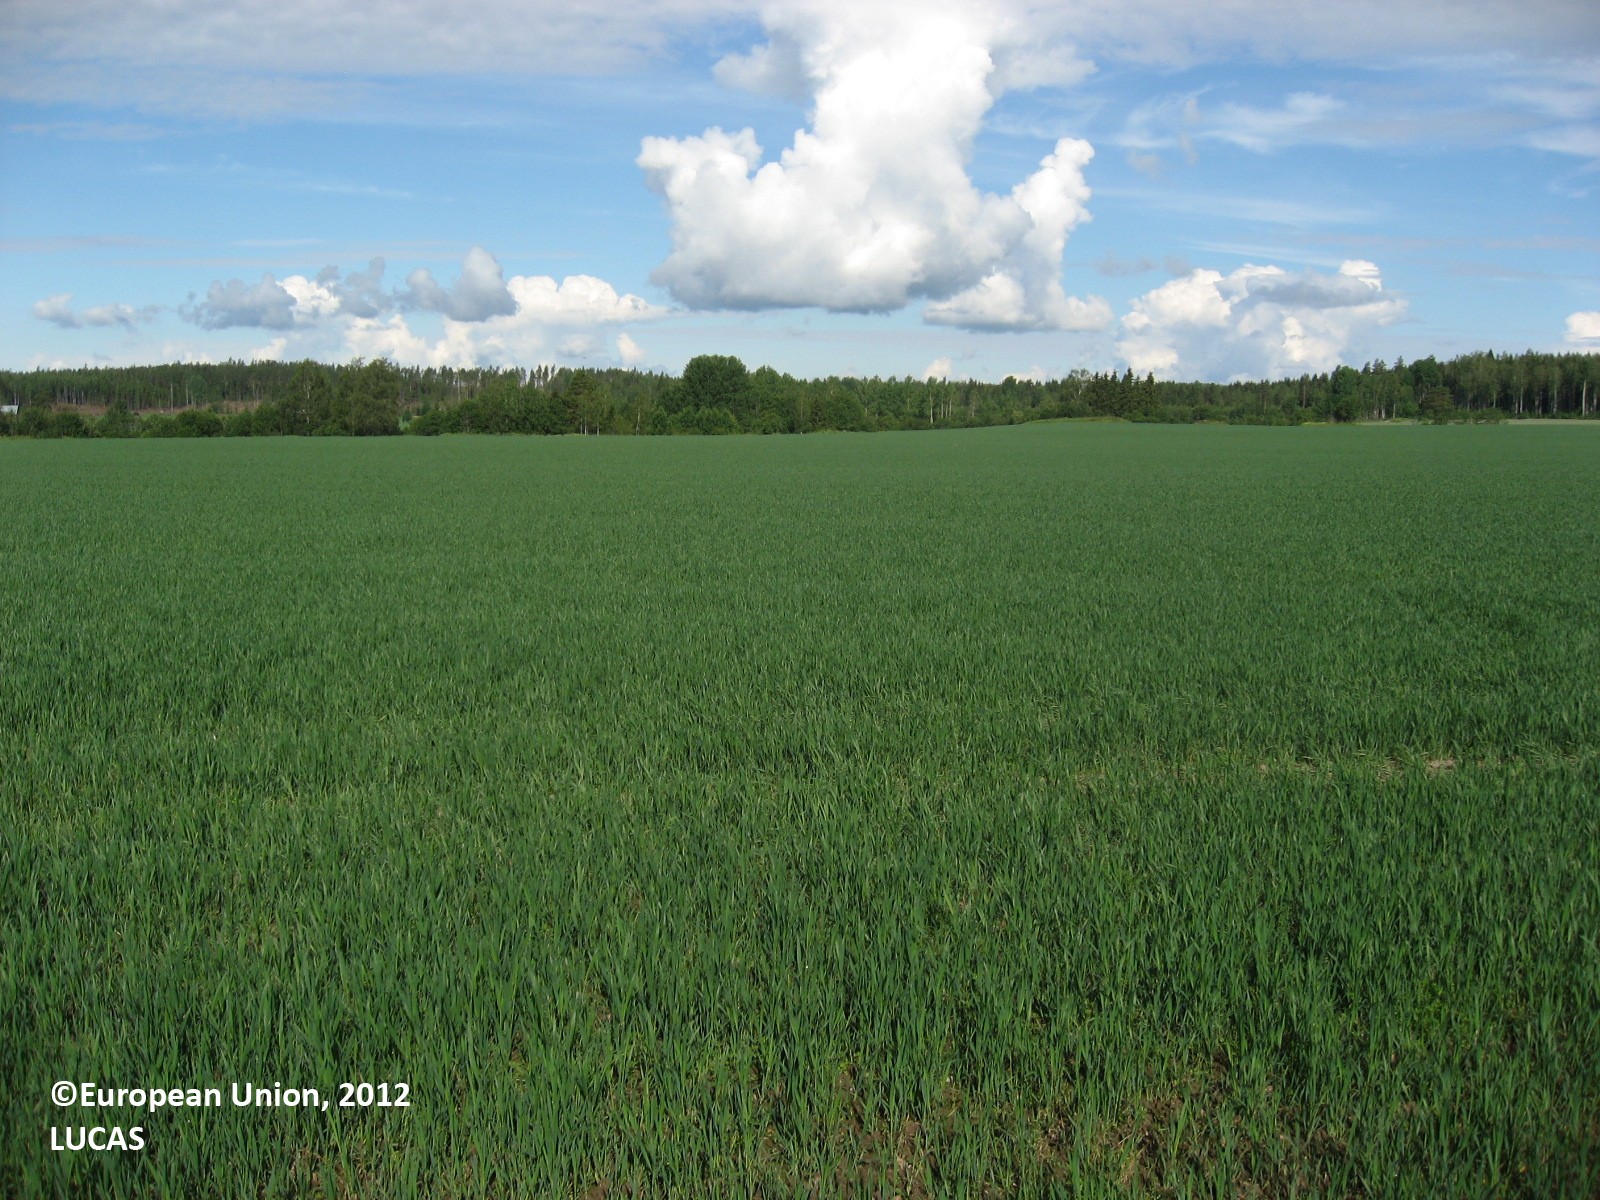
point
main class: Cropland
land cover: Common wheat
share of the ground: 50 - 75 %
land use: Agriculture (excluding fallow land and kitchen gardens)
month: June
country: FI
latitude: 60.6908
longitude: 26.2069
